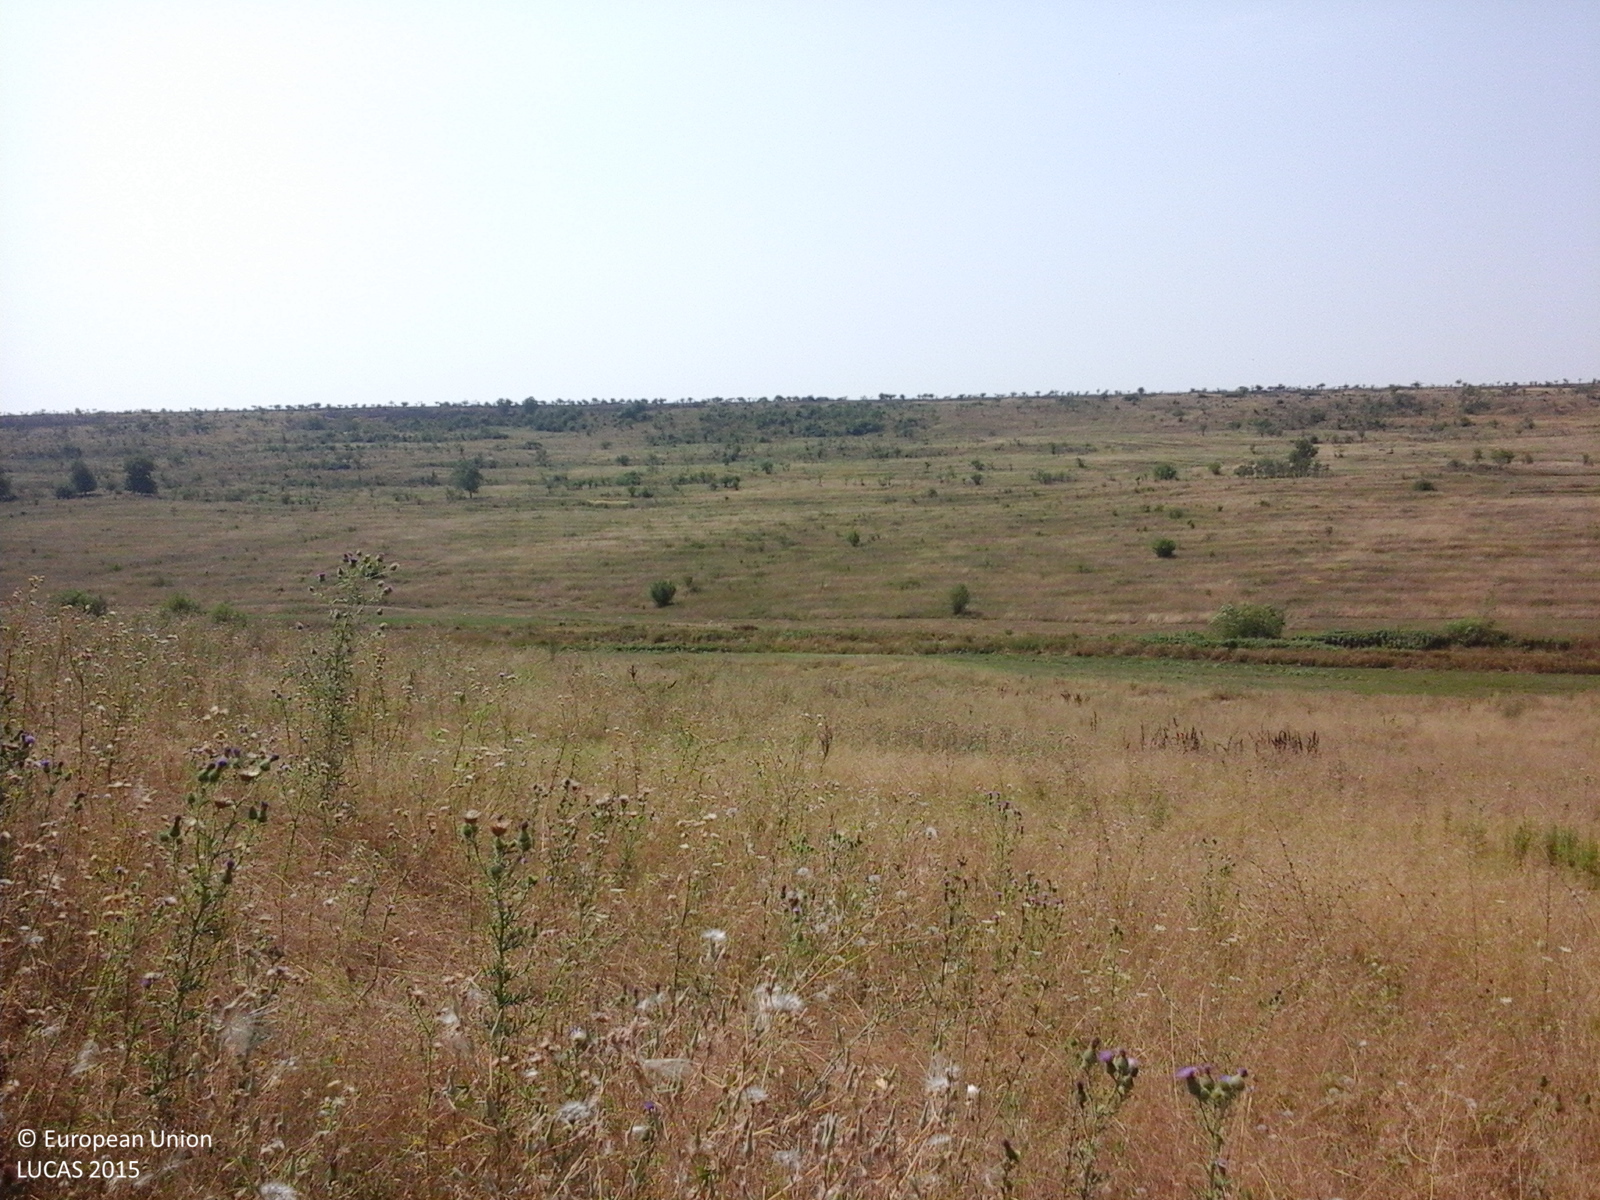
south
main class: Grassland
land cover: Spontaneously vegetated surfaces
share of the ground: > 75 %
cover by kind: herbaceous plants 100 %
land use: Fallow land
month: August
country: RO
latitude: 44.3842
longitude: 23.4446
